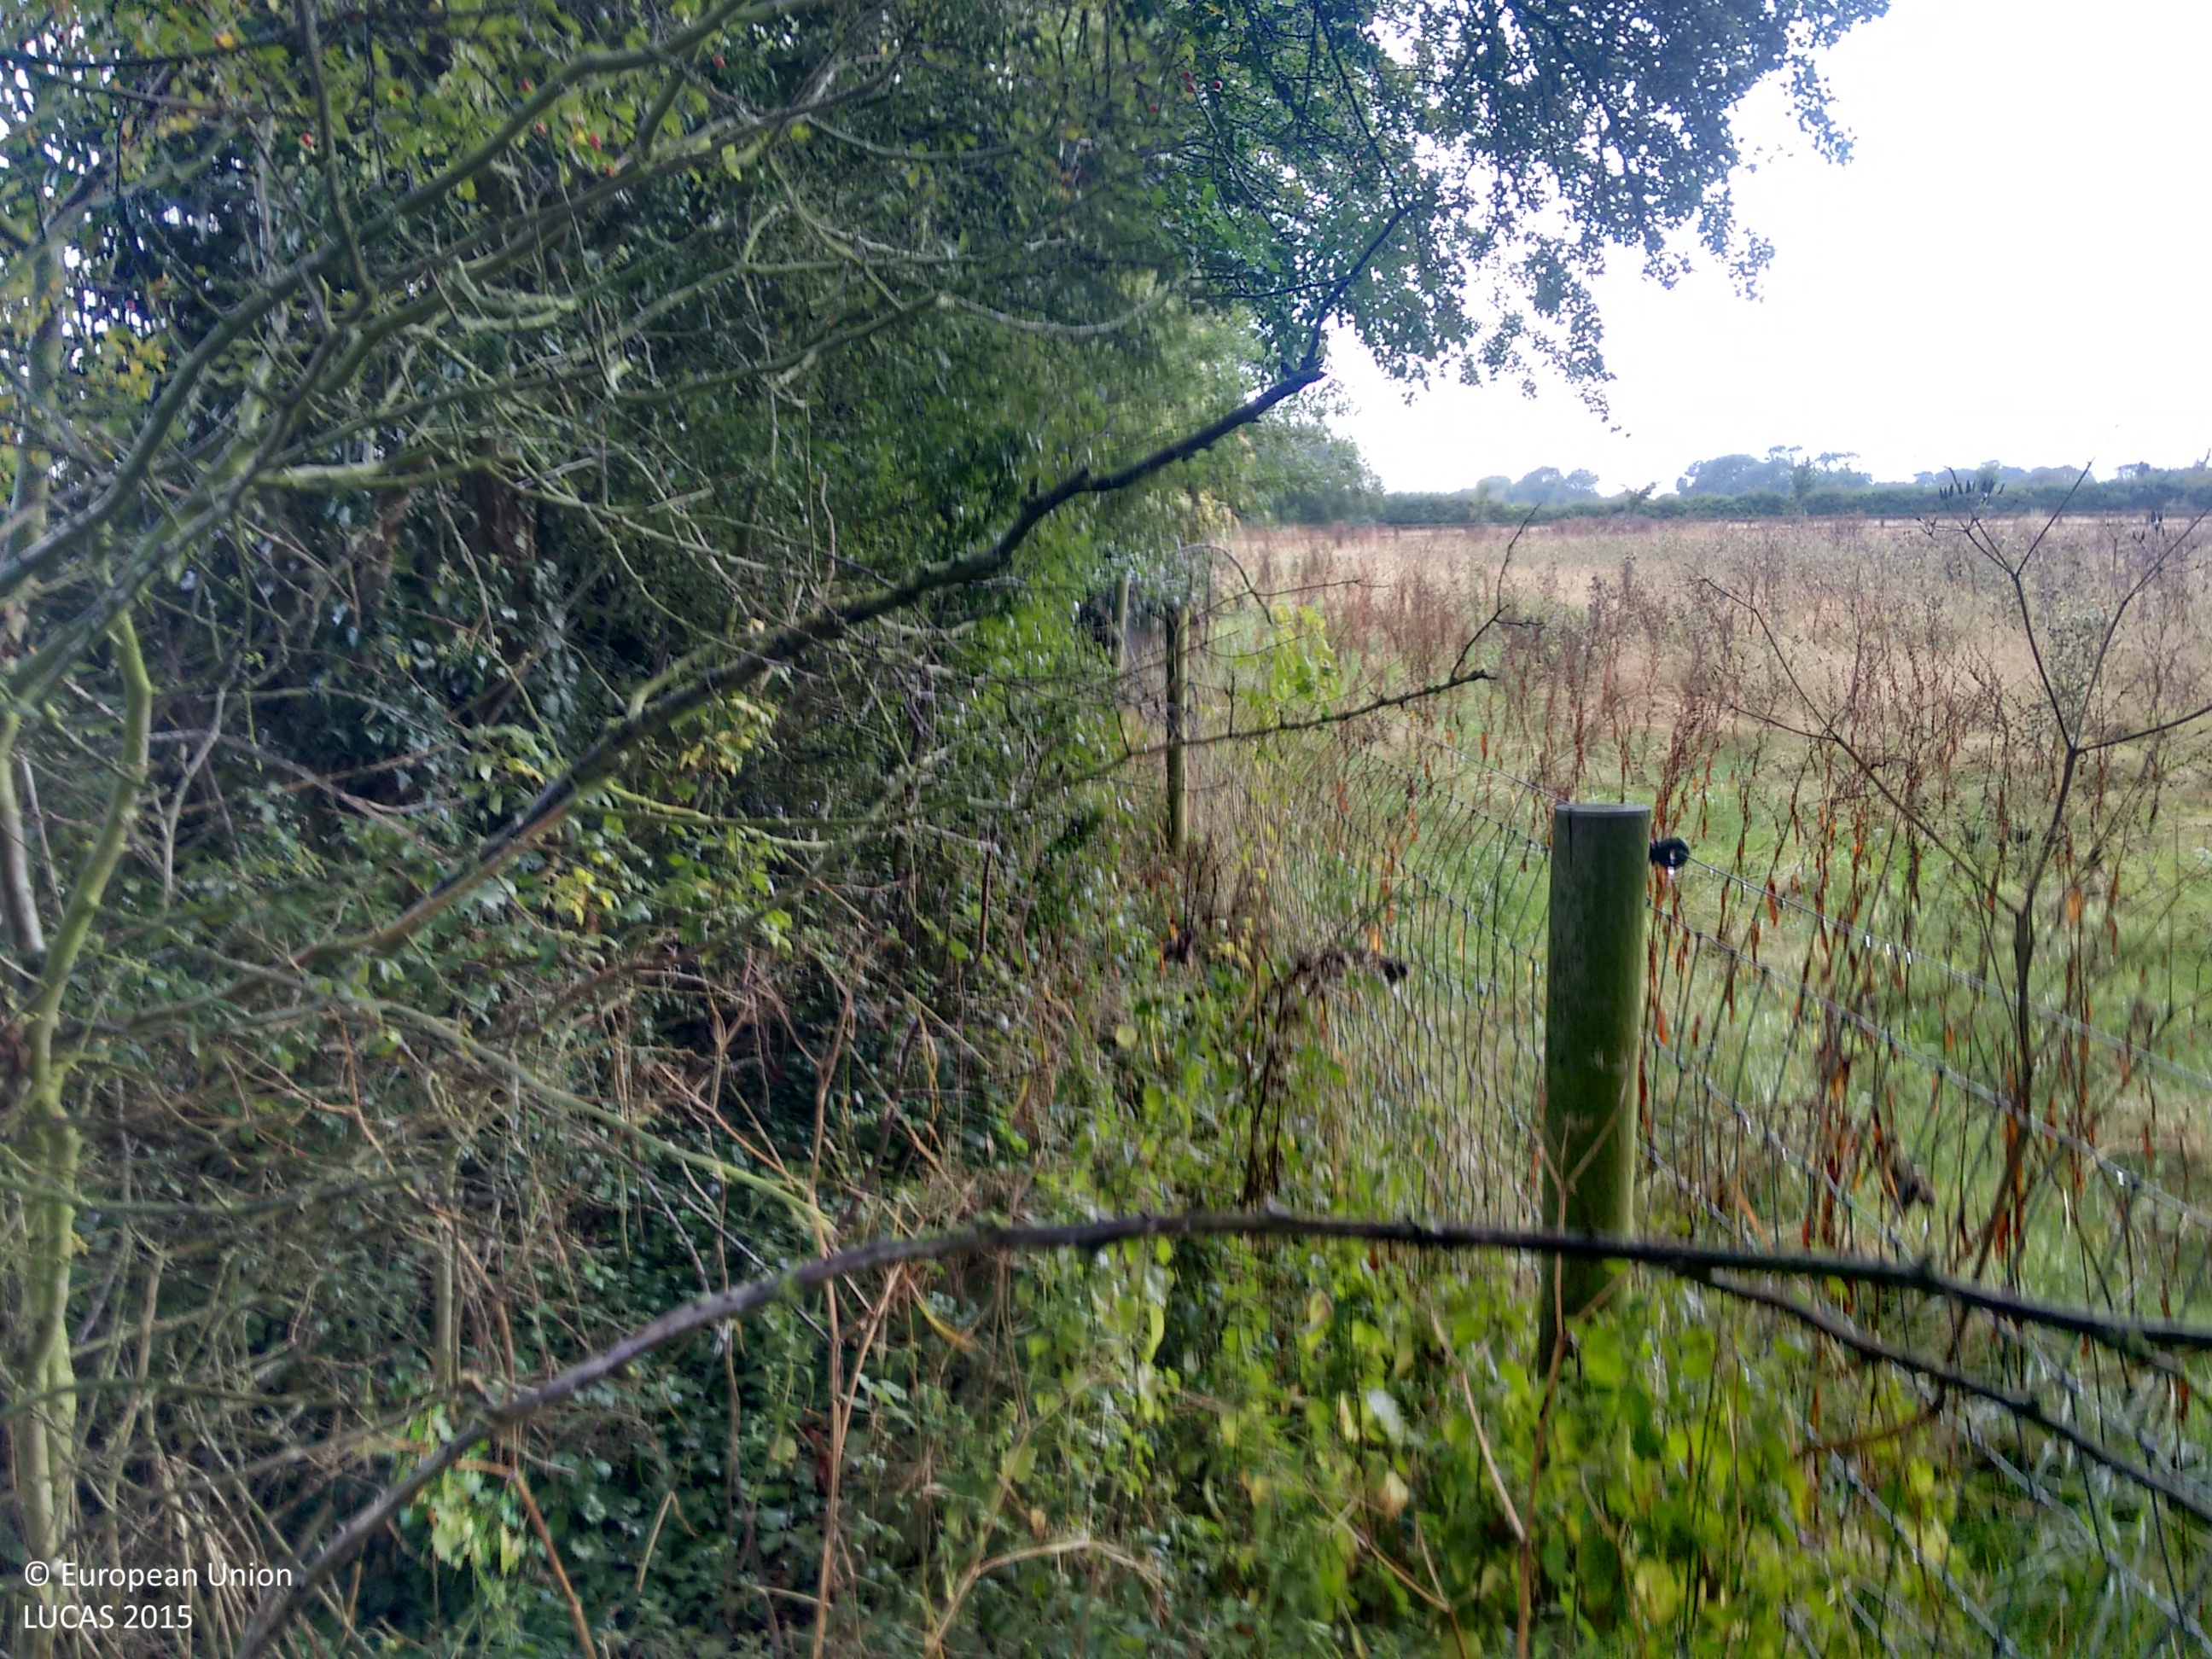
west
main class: Grassland
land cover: Spontaneously vegetated surfaces
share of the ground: > 75 %
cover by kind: herbaceous plants 100 %
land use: Agriculture (excluding fallow land and kitchen gardens)
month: September
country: GB
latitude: 52.2036
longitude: 1.5676
